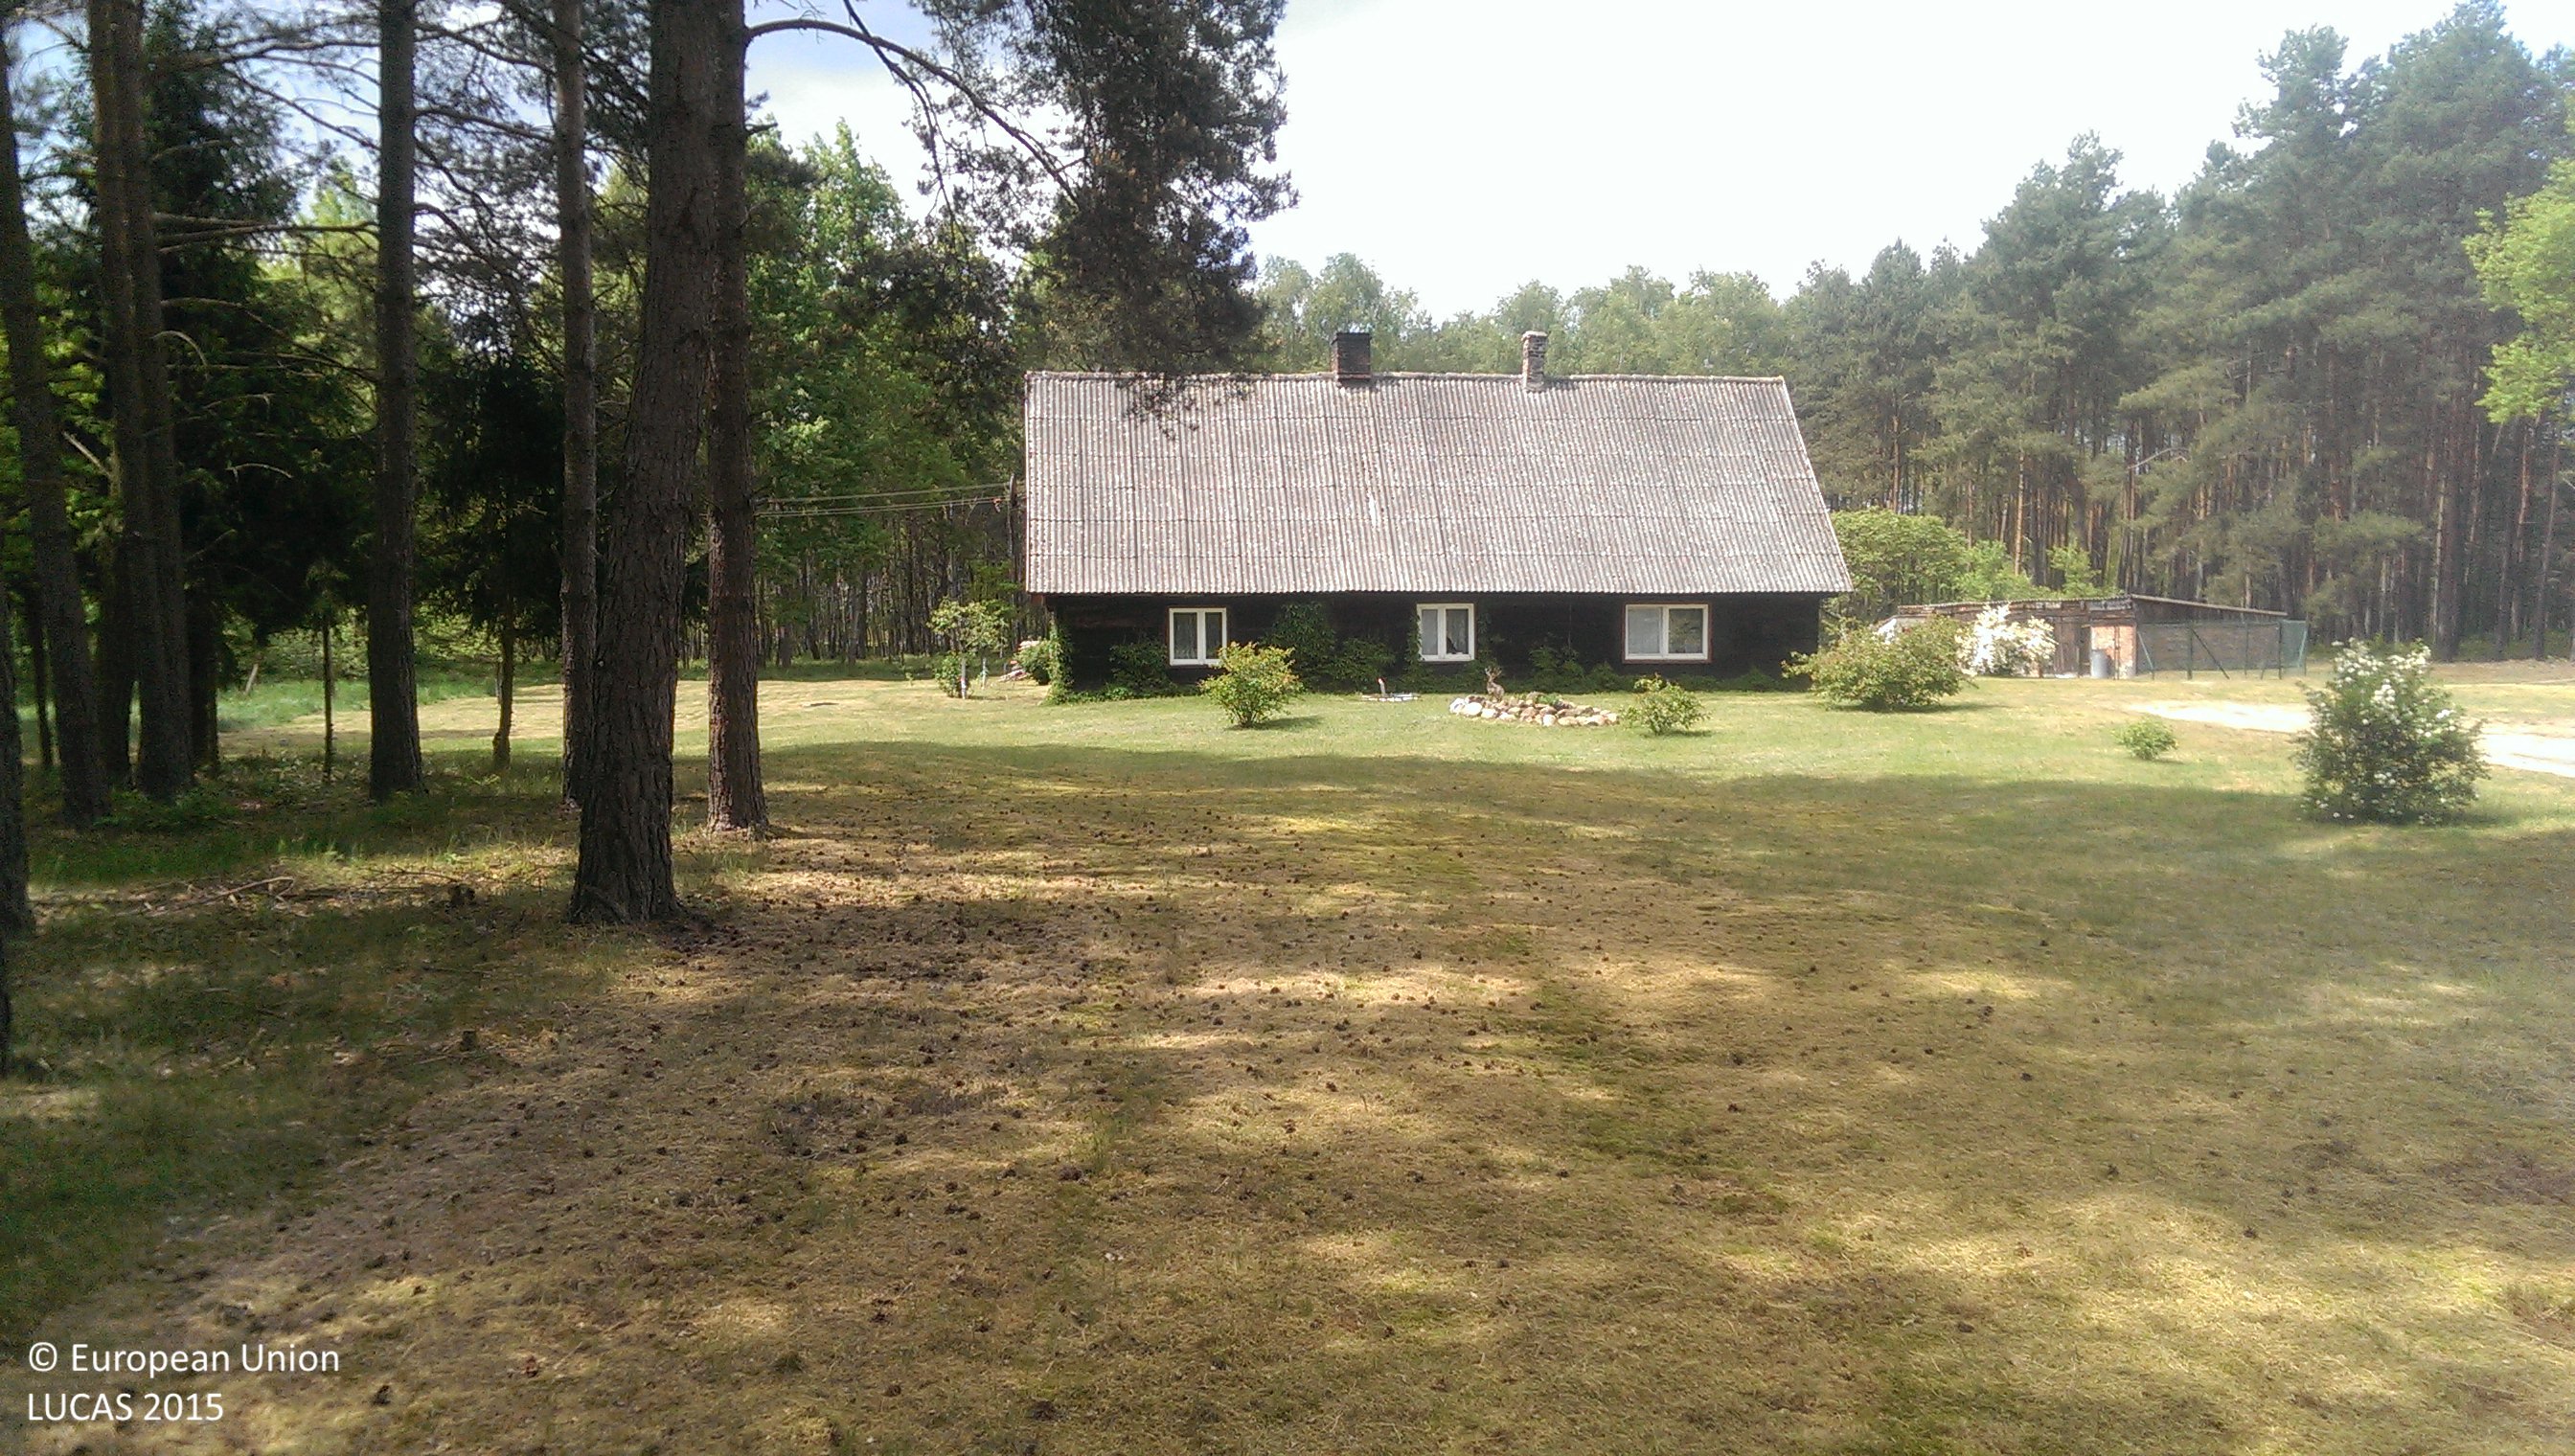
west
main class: Grassland
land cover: Grassland without tree/shrub cover
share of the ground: > 75 %
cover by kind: herbaceous plants 85 %, unconsolidated bare surface 15 %
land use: Residential
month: May
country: PL
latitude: 52.2335
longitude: 16.2001
